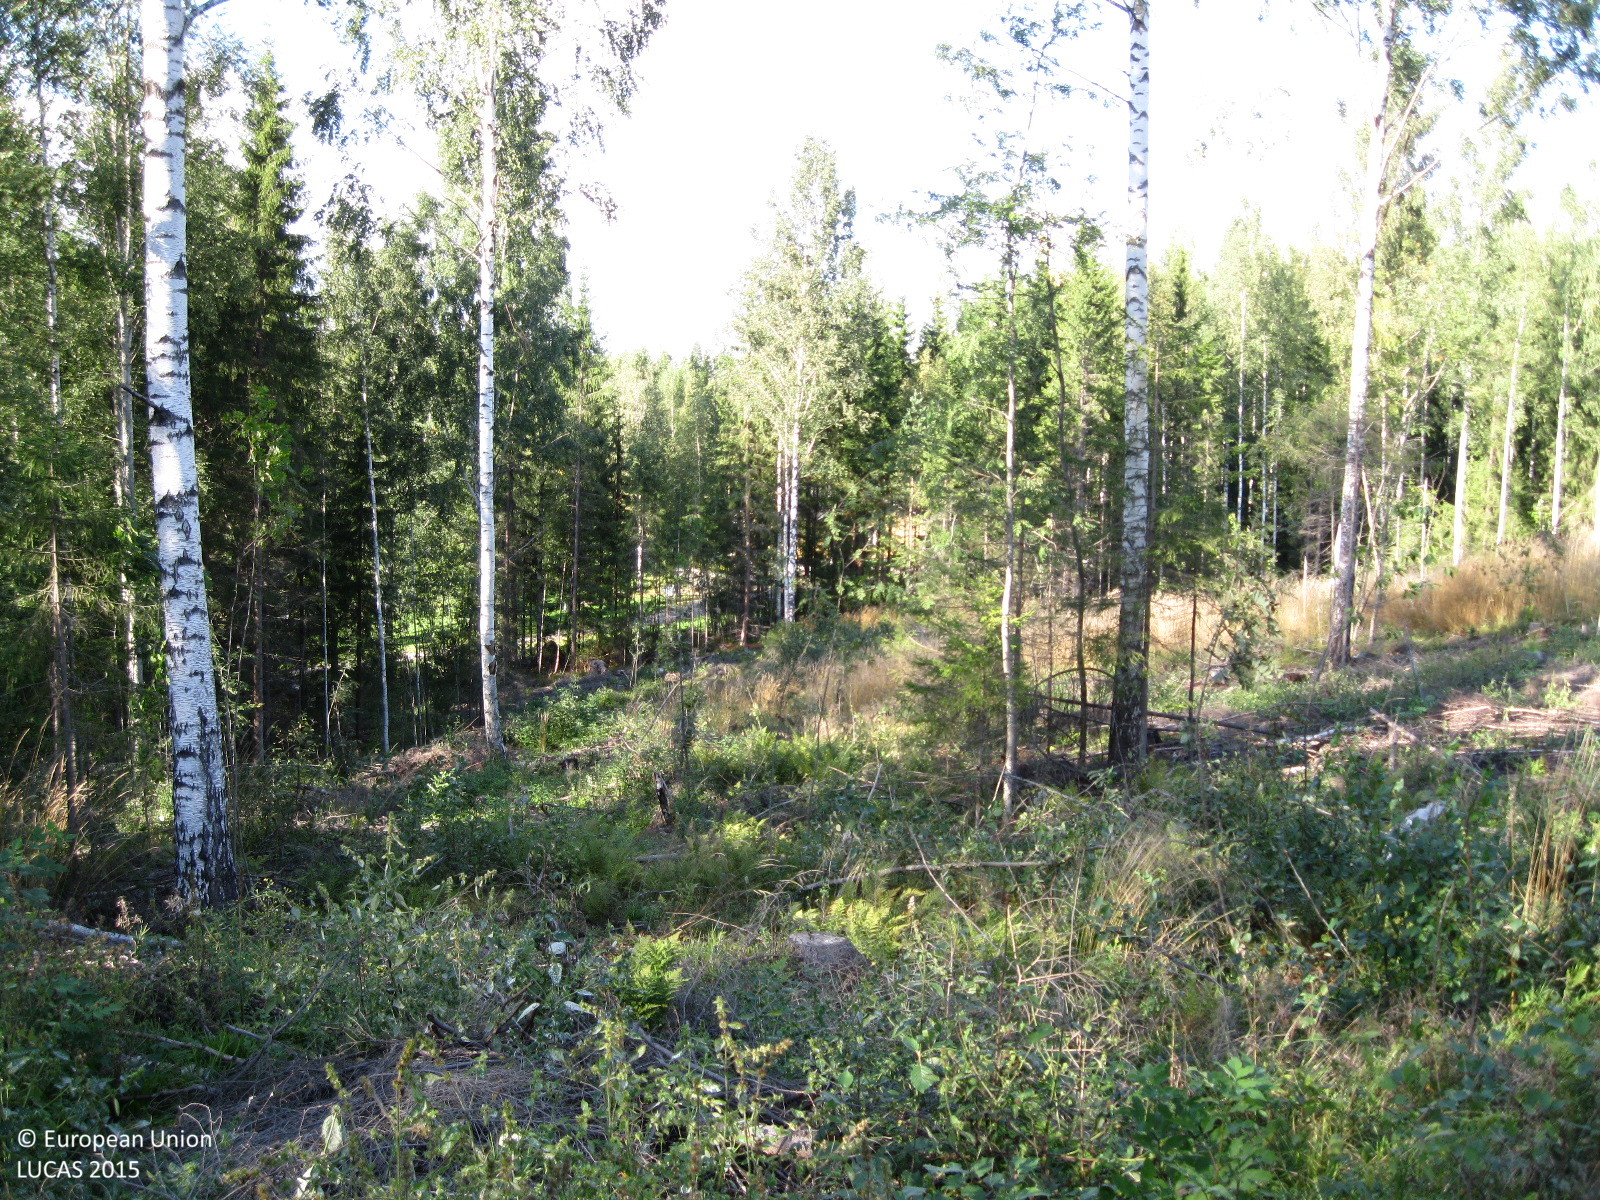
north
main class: Woodland
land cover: Broadleaved woodland
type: boreal forest
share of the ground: > 75 %
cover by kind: herbaceous plants 85 %, broadleaved forest trees 10 %, shrubs 5 %
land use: Forestry
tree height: > 5 m
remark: Nursery
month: September
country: FI
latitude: 60.5167
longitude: 24.7752
